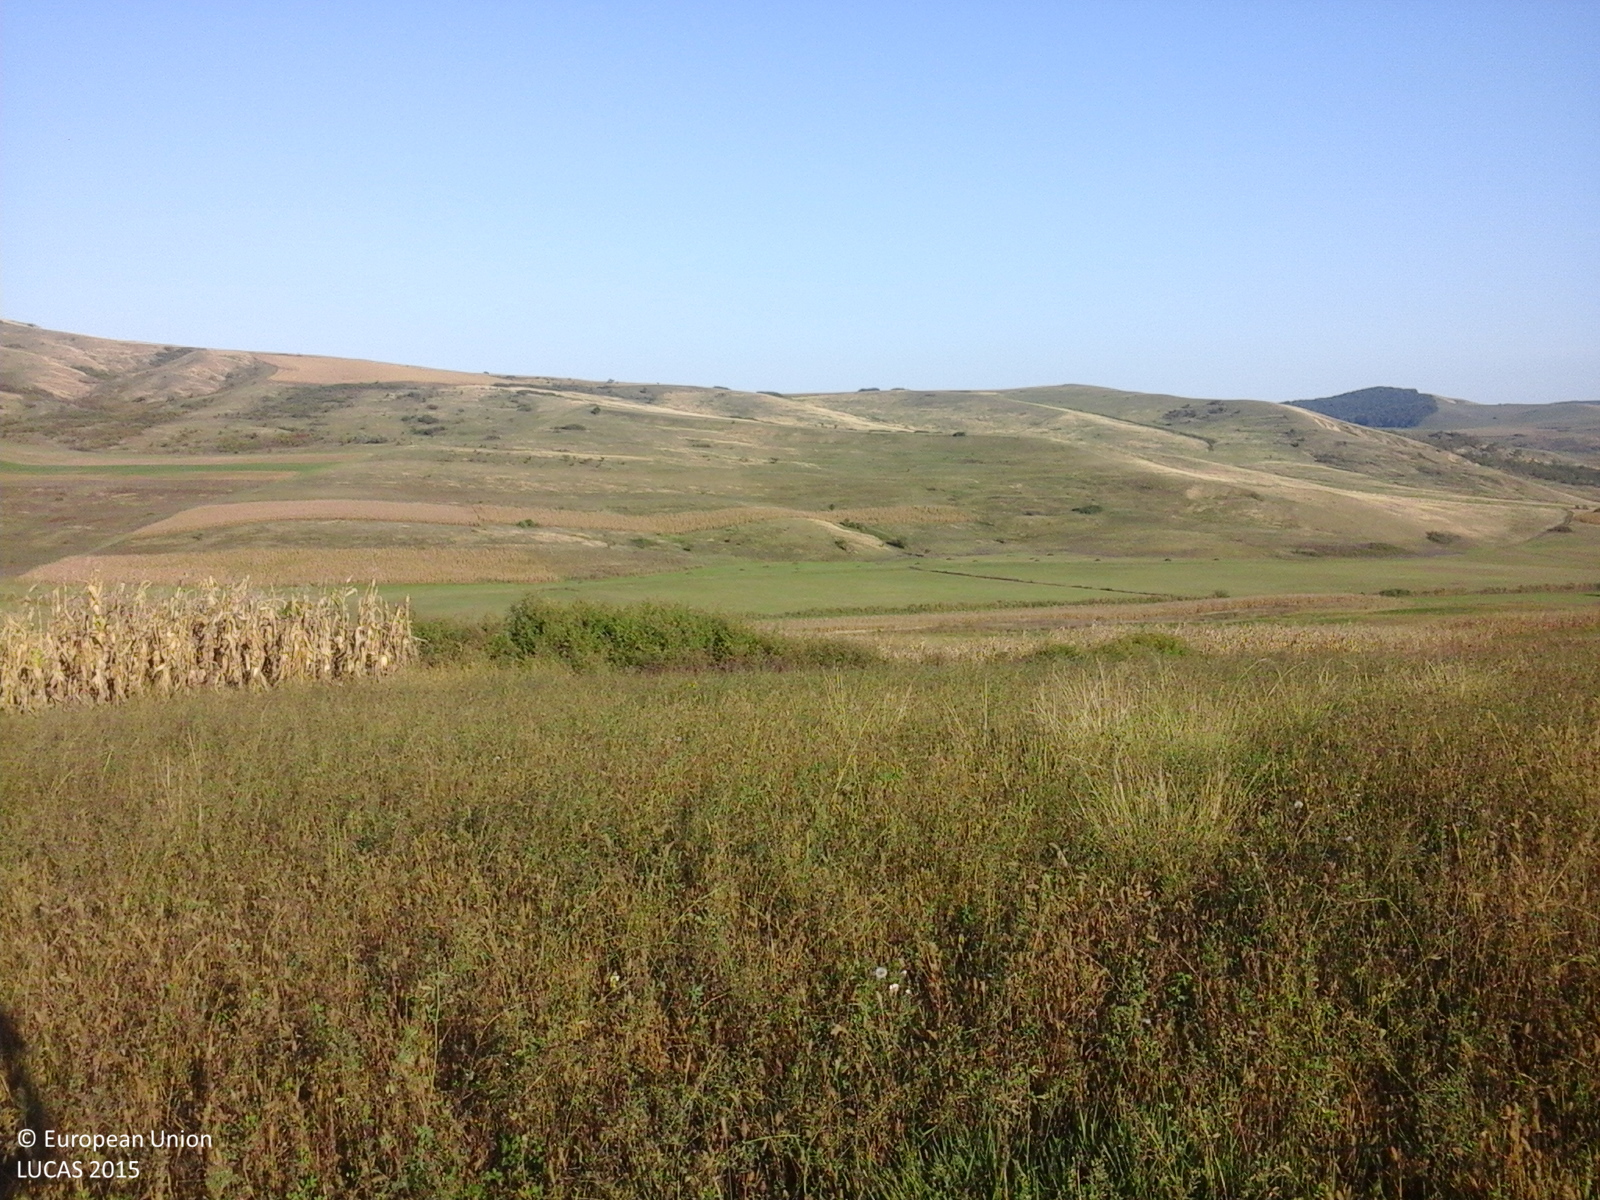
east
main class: Grassland
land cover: Spontaneously vegetated surfaces
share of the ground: > 75 %
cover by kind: herbaceous plants 100 %
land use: Agriculture (excluding fallow land and kitchen gardens)
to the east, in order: Spontaneously vegetated surfaces; Shrubland without tree cover; Spontaneously vegetated surfaces; Maize; Lucerne; Spontaneously vegetated surfaces; Maize; Grass margins; Tracks; Spontaneously vegetated surfaces
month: October
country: RO
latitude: 46.2329
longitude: 23.8298
